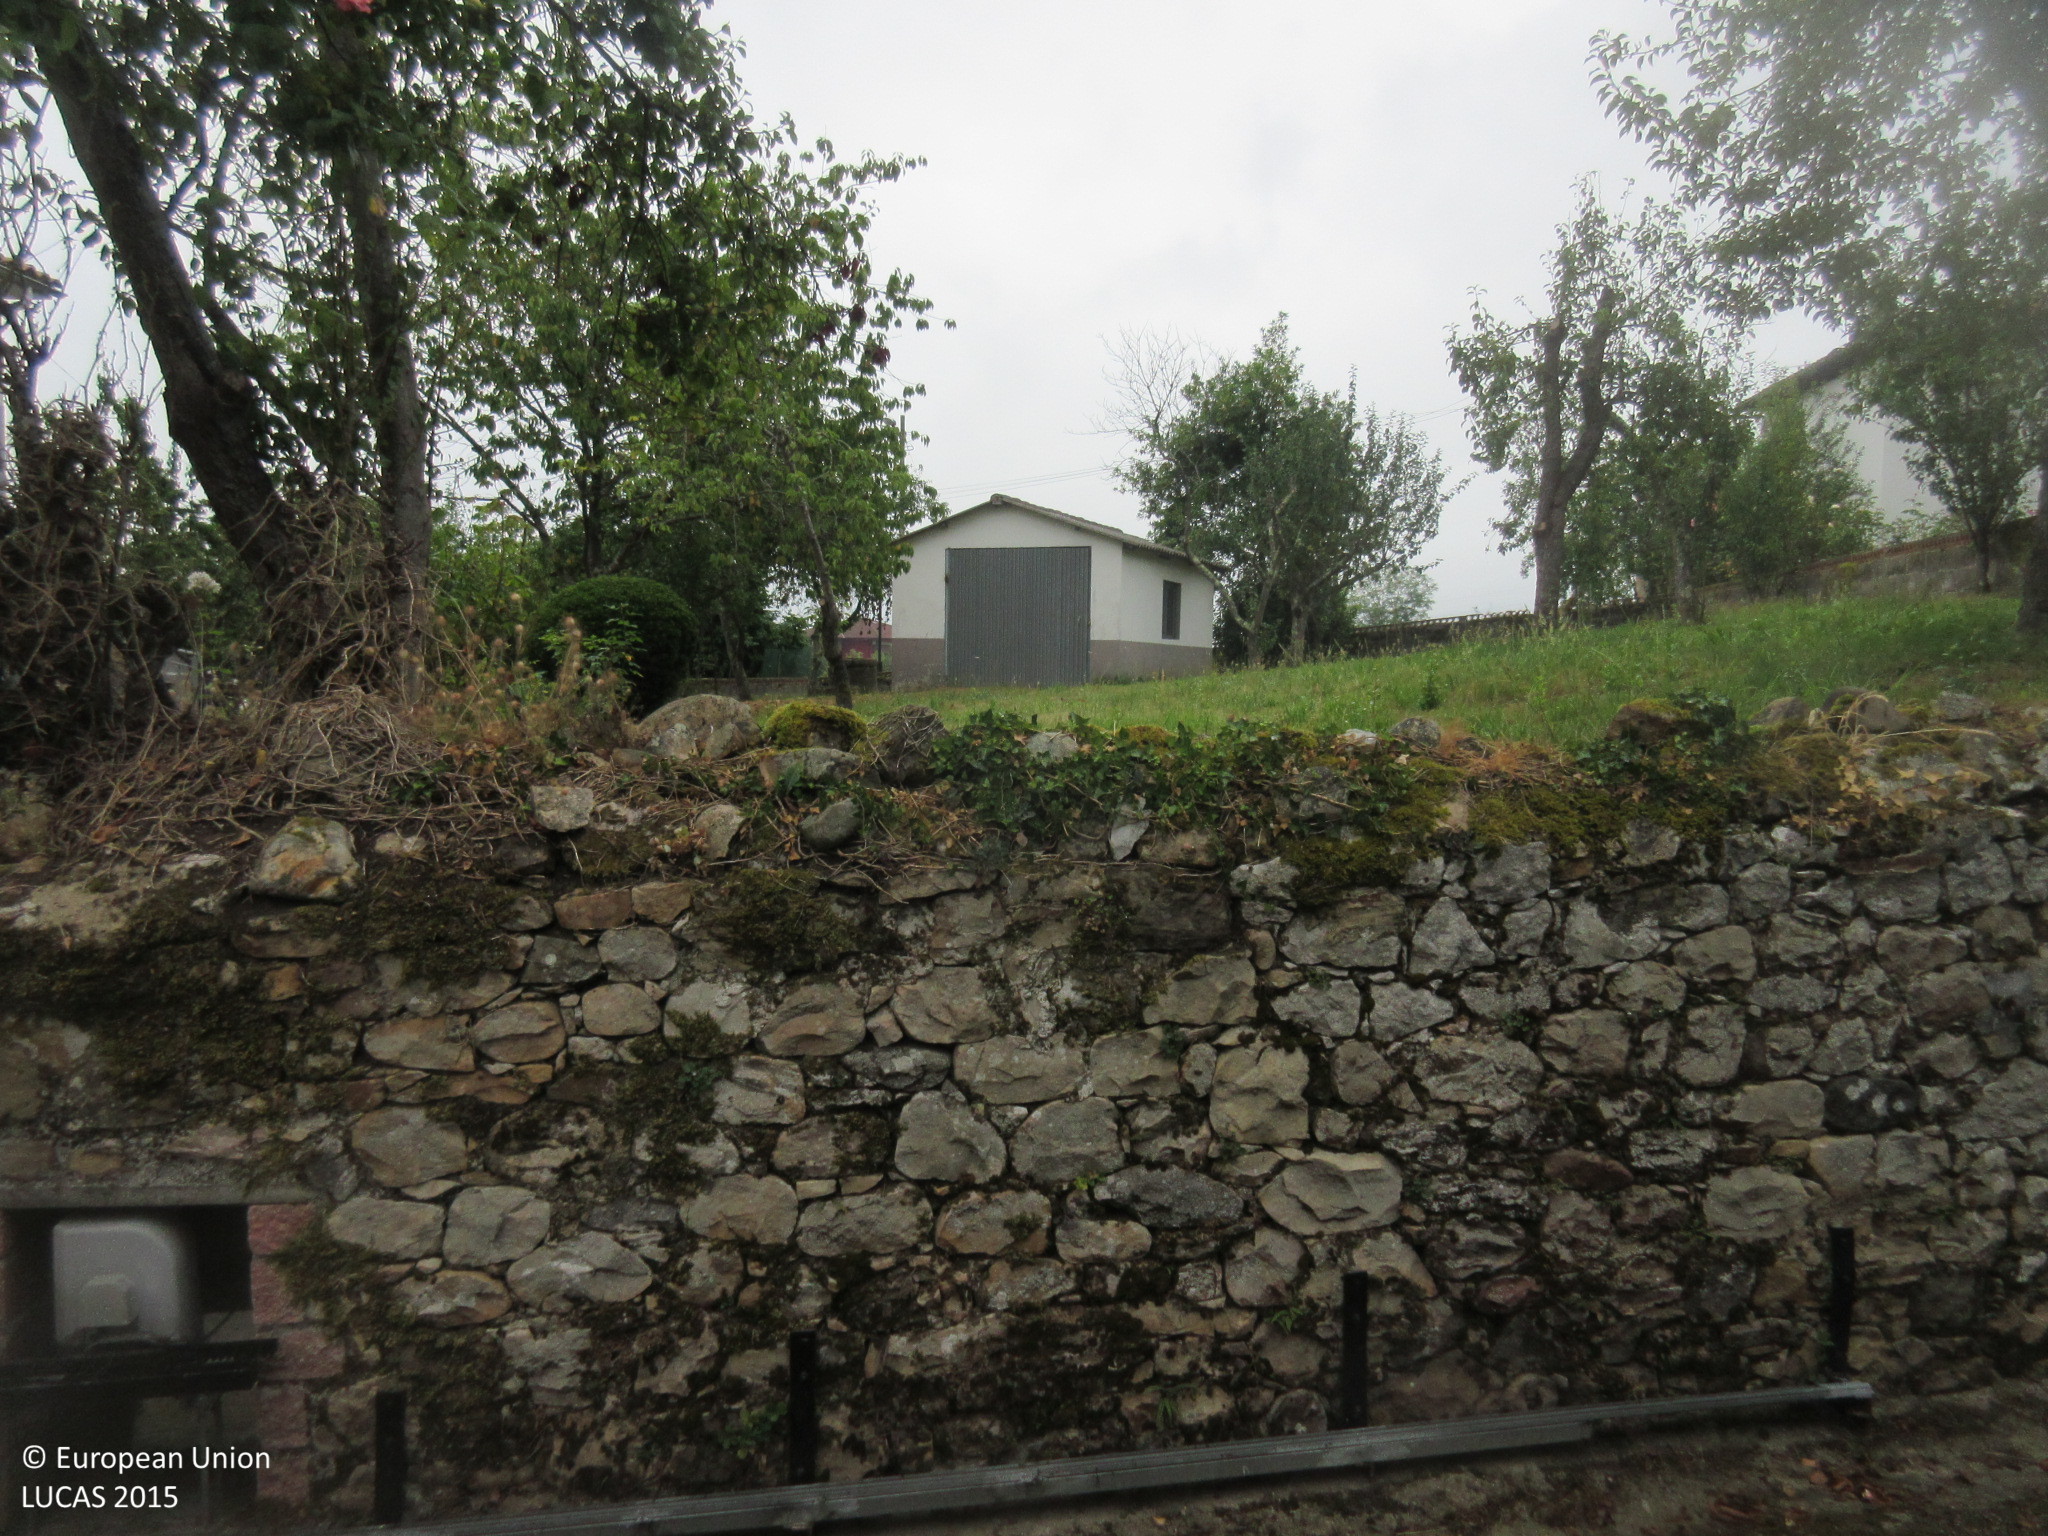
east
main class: Grassland
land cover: Grassland with sparse tree/shrub cover
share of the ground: > 75 %
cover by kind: herbaceous plants 95 %, broadleaved forest trees 5 %
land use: Residential
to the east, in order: Grassland with sparse tree/shrub cover; Artificial constructions in urban areas; Tracks; Dry stone walls; Apple fruit; Artificial constructions; Tracks; Dry stone walls; Electric lines; Grassland without tree/shrub cover; Managed hedges; Grassland without tree/shrub cover; Tracks; Artificial constructions in urban areas; Grassland without tree/shrub cover; Fences; Grassland without tree/shrub cover; Electric lines; Grassland without tree/shrub cover
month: July
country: ES
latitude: 43.3600
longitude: -5.2644
